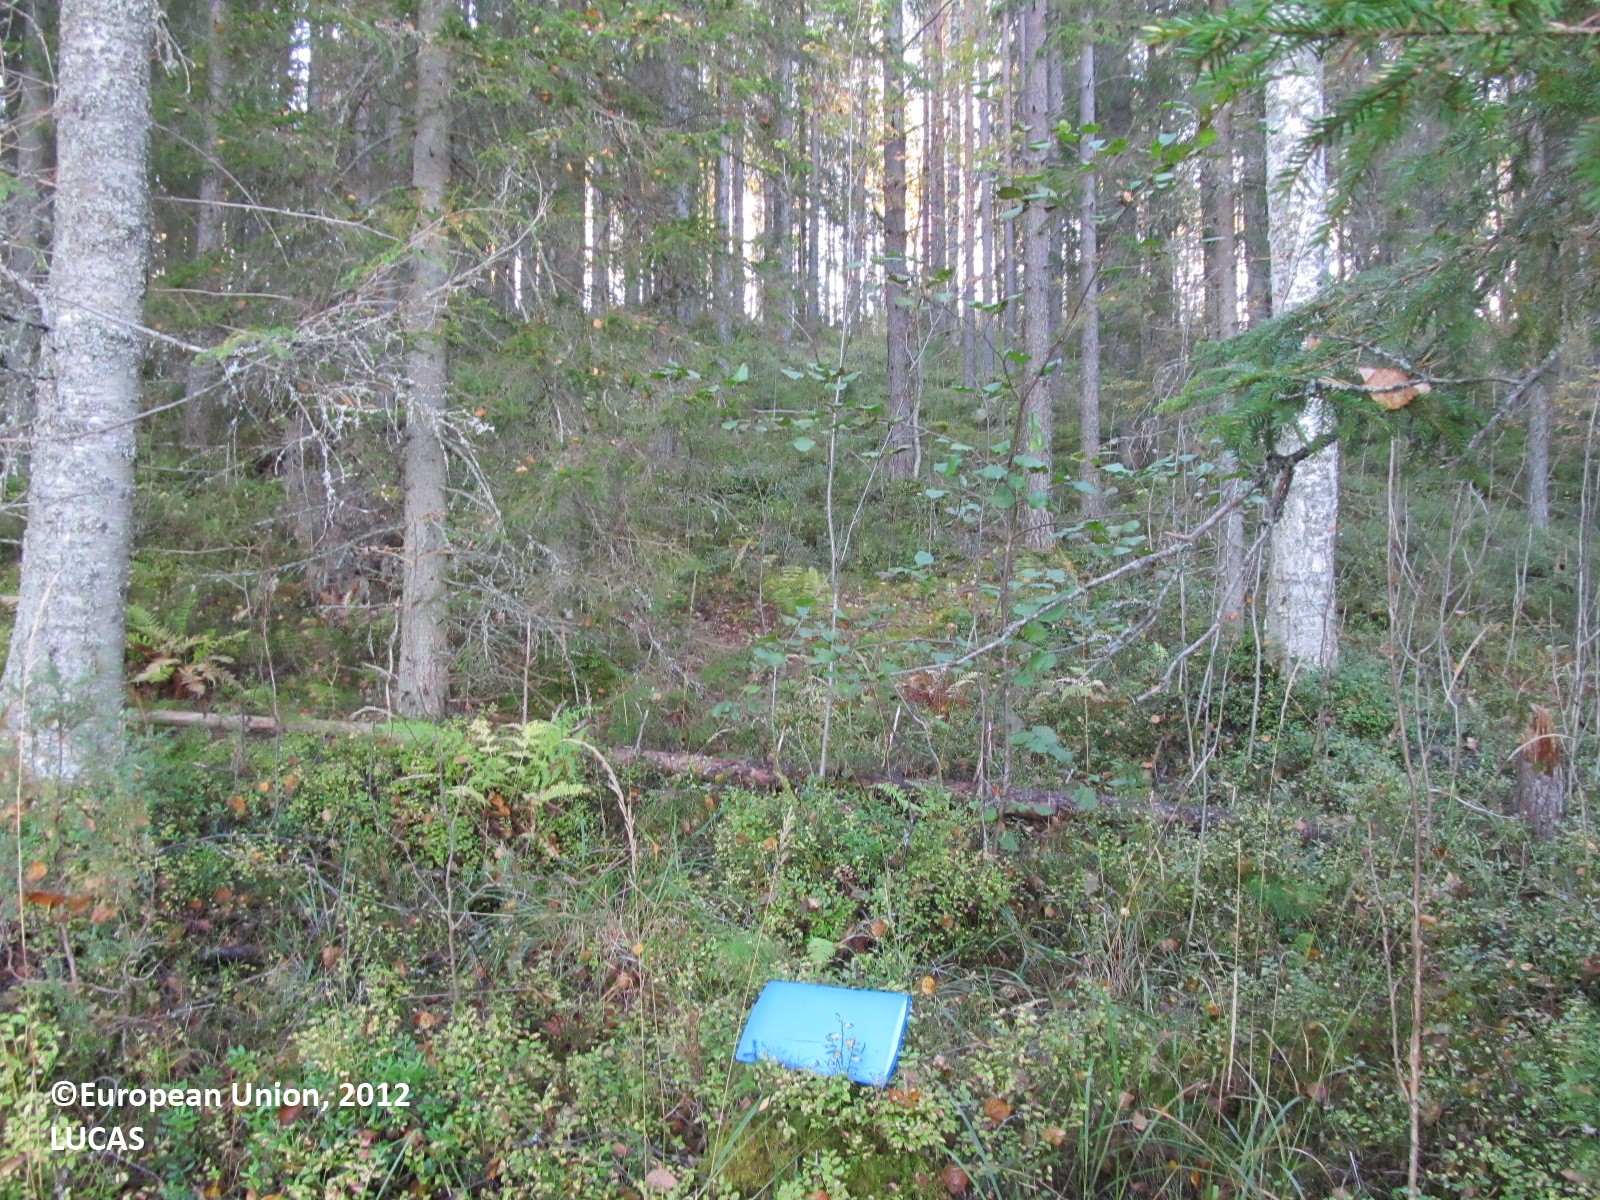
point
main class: Woodland
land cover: Spruce dominated mixed woodland
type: boreal forest
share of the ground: 25 - 50 %
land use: Forestry
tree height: > 5 m
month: September
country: FI
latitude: 62.3739
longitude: 28.5496
